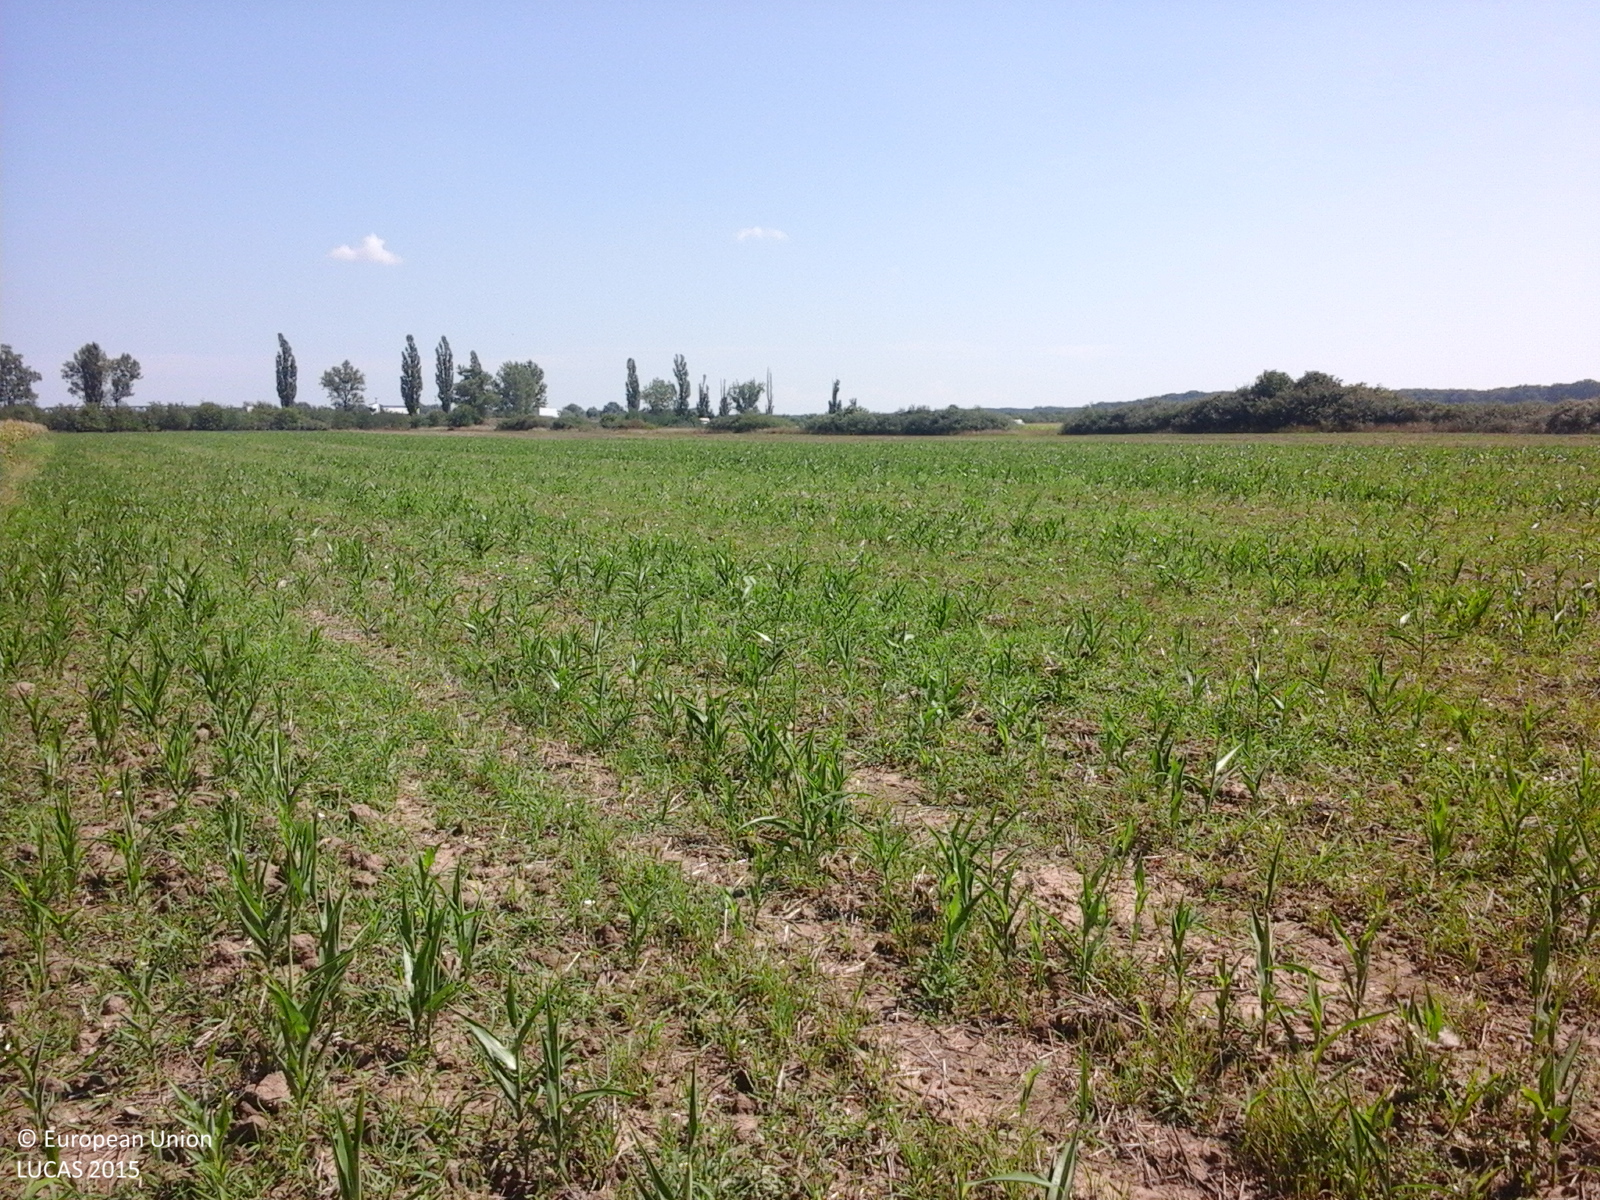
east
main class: Cropland
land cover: Maize
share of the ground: > 75 %
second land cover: Spontaneously vegetated surfaces
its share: > 75 %
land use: Agriculture (excluding fallow land and kitchen gardens)
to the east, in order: Maize; Spontaneously vegetated surfaces; Other cereals; Common wheat
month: August
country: RO
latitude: 45.6362
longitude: 21.1774
